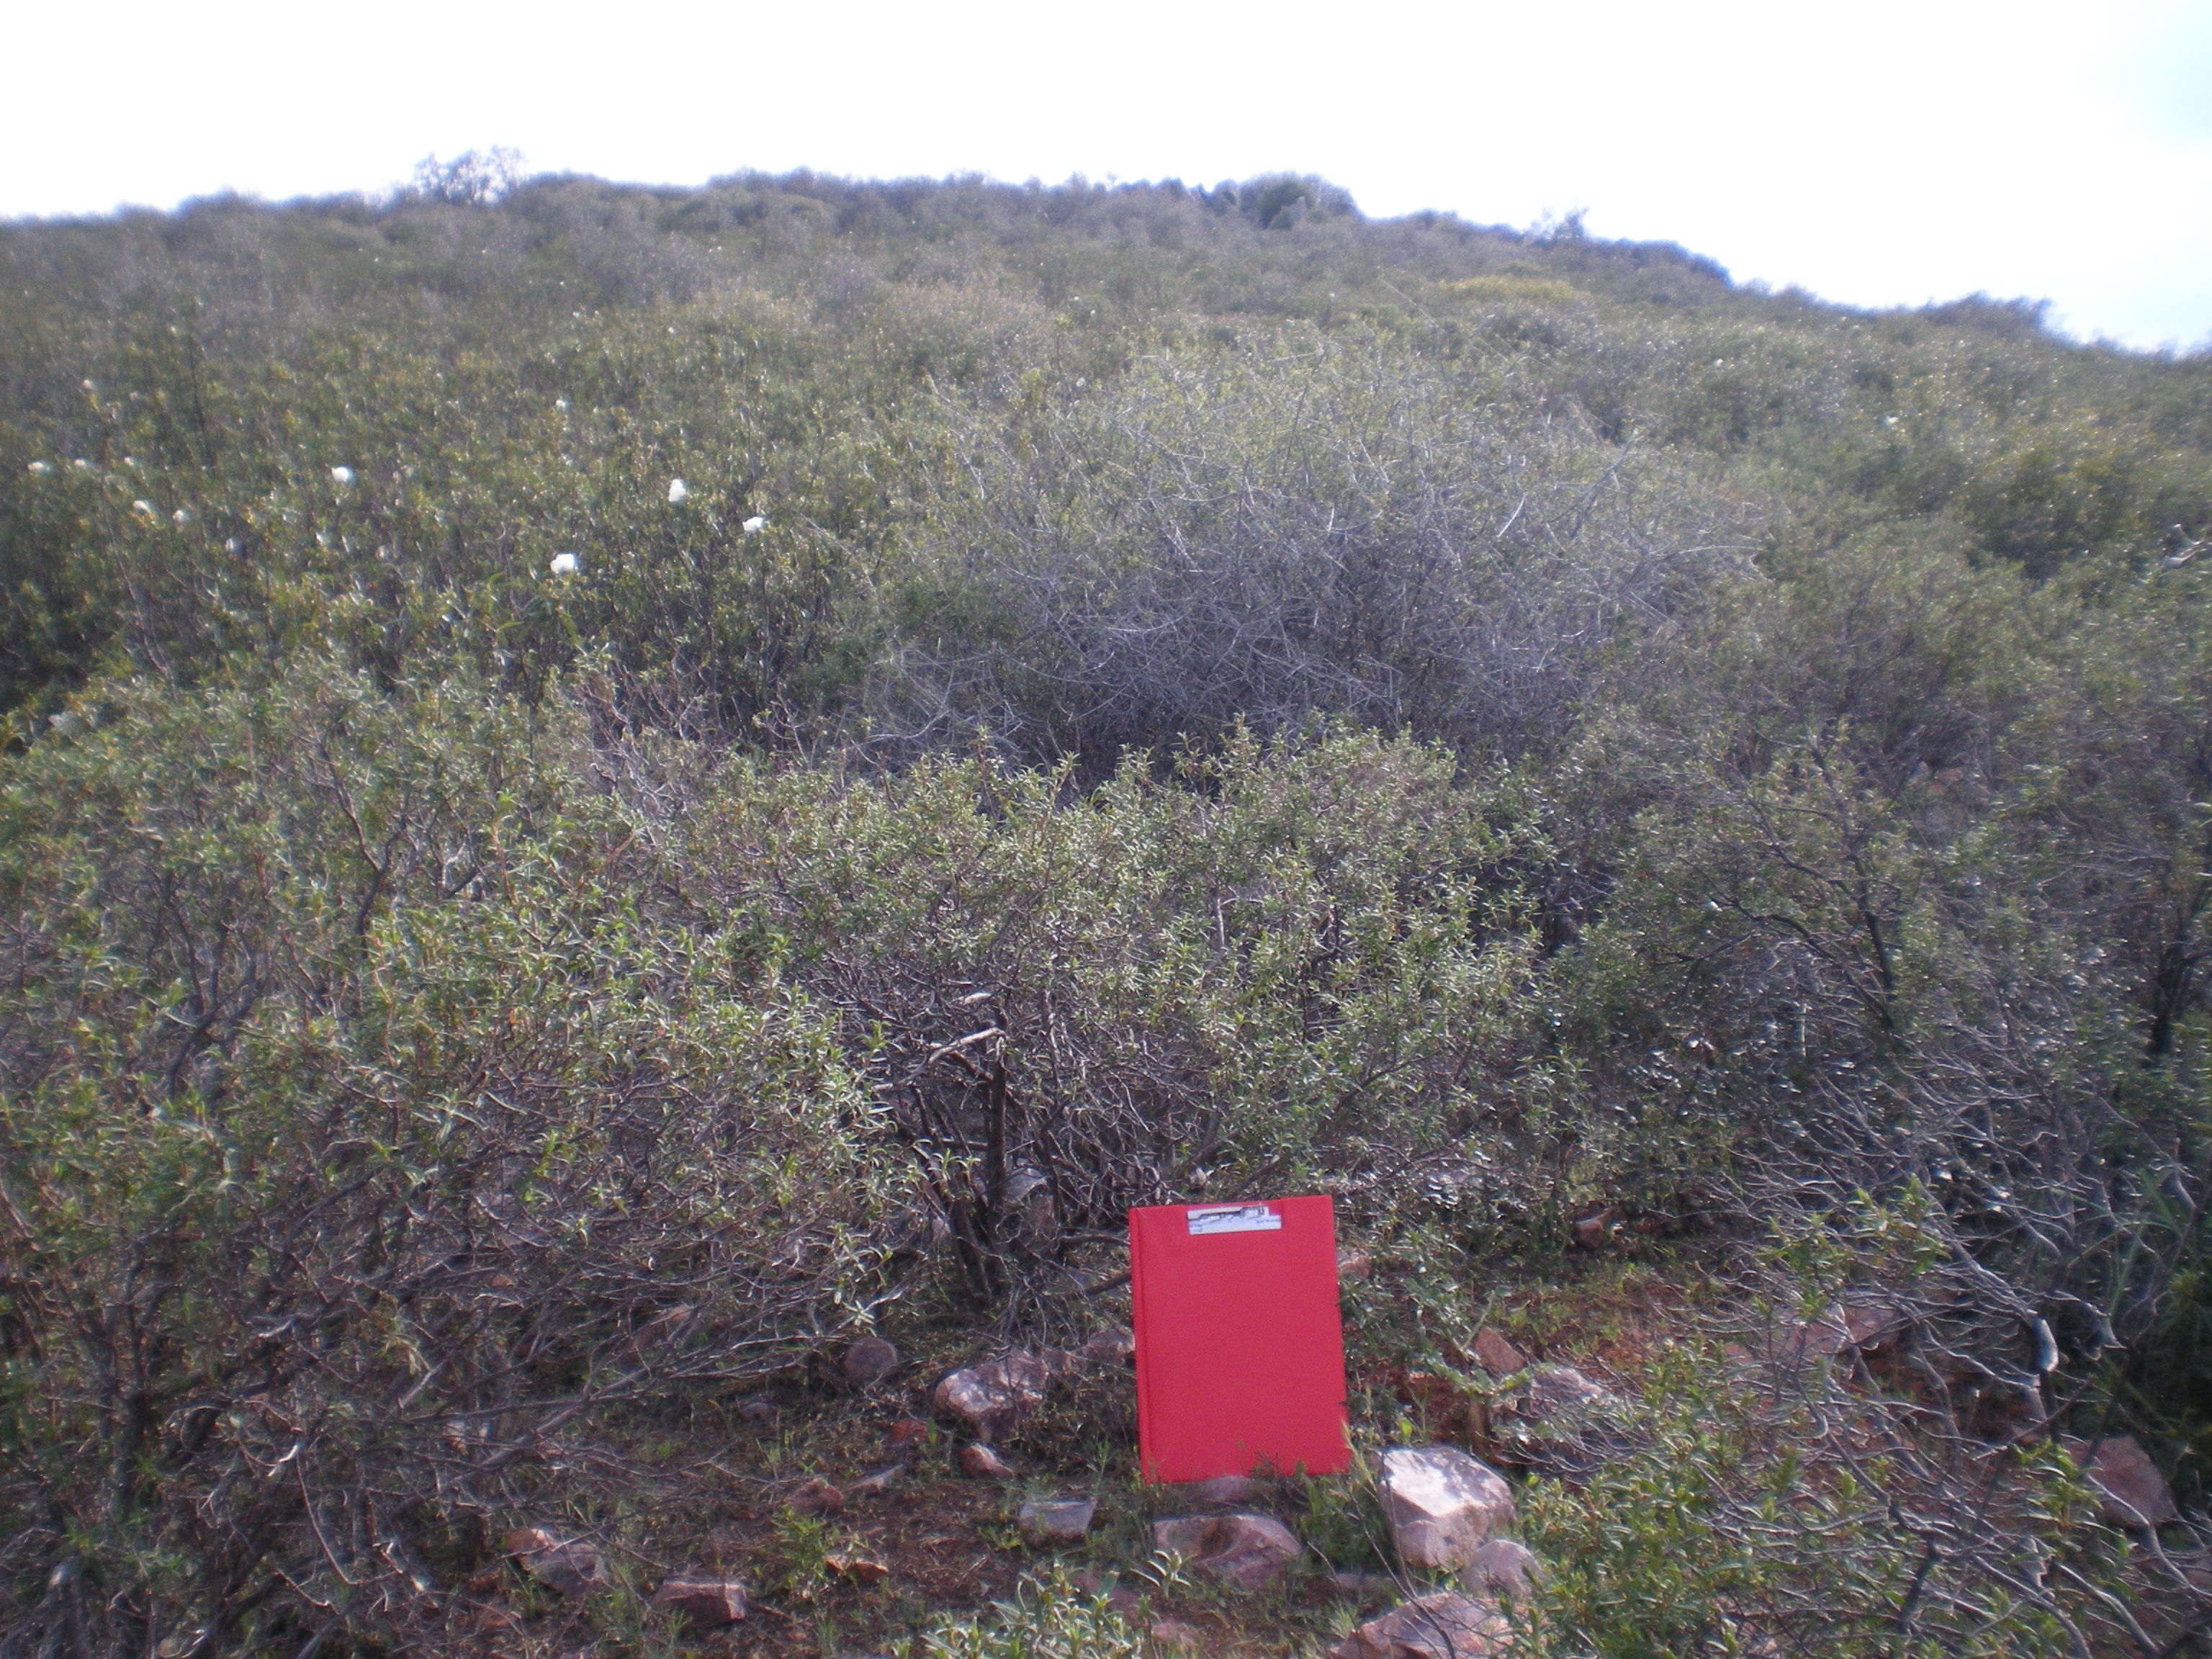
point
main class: Shrubland
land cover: Shrubland with sparse tree cover
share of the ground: > 75 %
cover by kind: shrubs 80 %, herbaceous plants 10 %, broadleaved forest trees 5 %, unconsolidated bare surface 5 %
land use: Other primary production
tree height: < 5 m
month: April
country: ES
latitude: 38.8846
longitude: -3.5367
